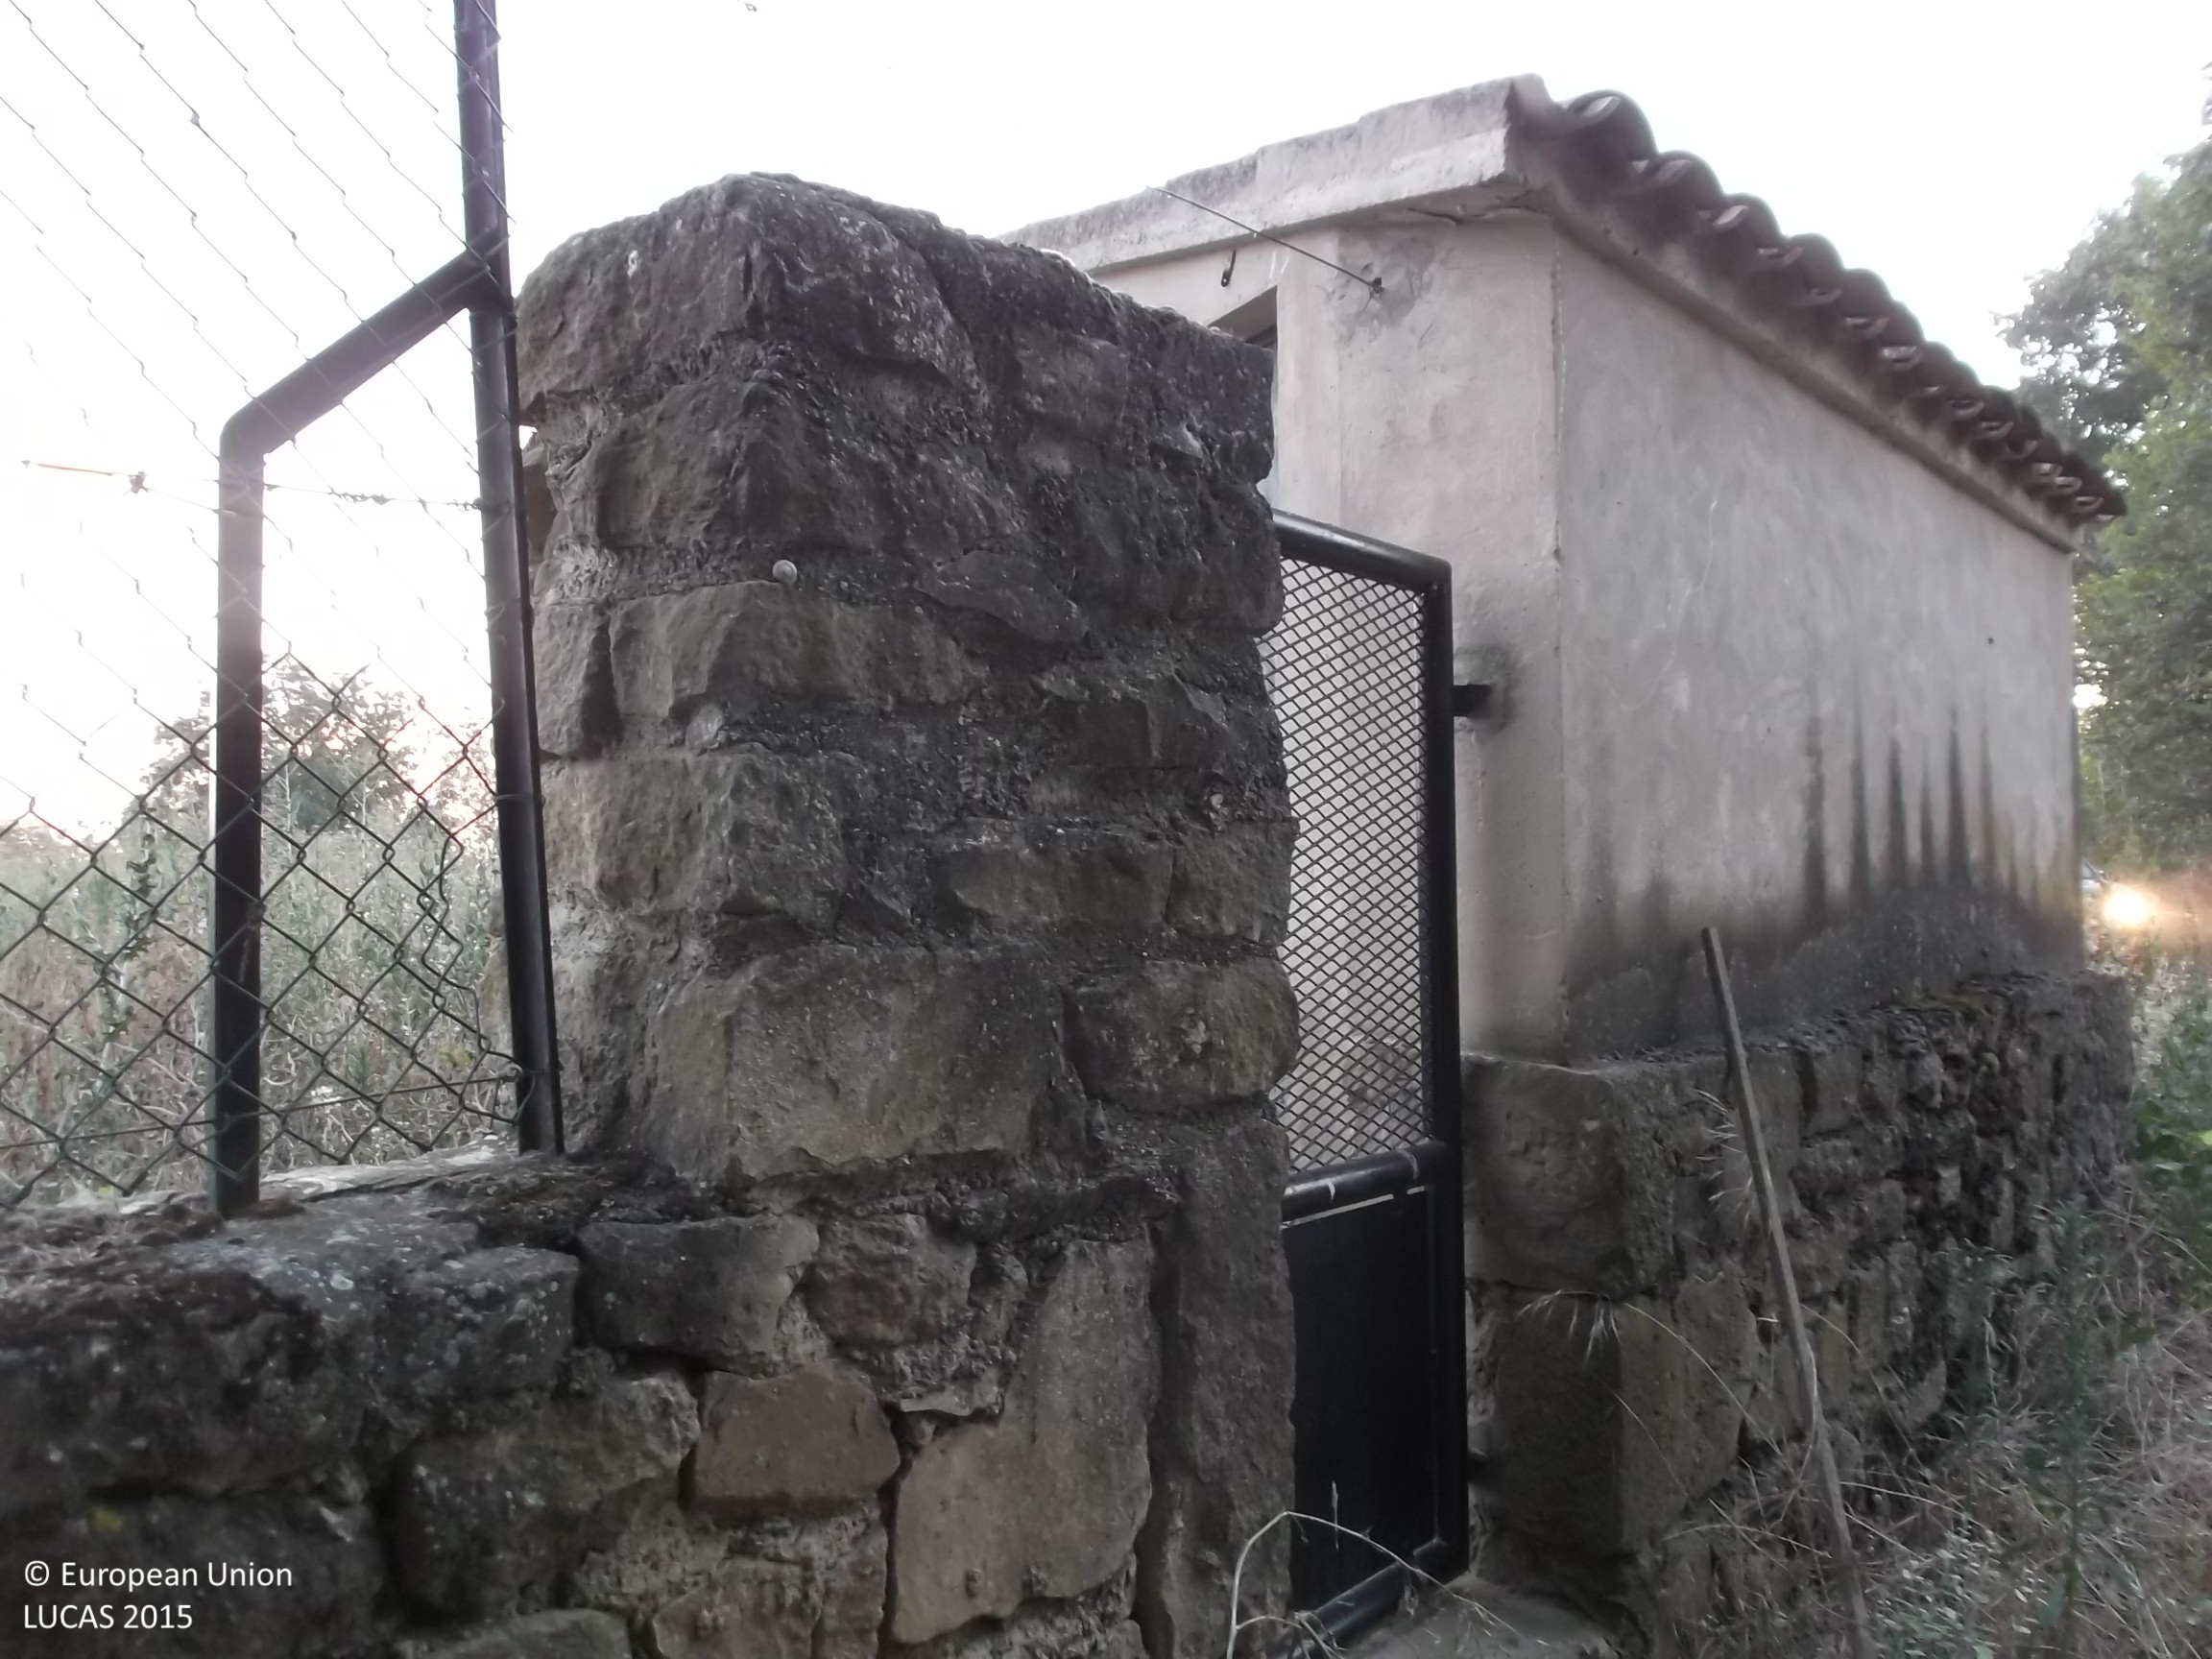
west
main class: Grassland
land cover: Spontaneously vegetated surfaces
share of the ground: > 75 %
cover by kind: herbaceous plants 90 %, unconsolidated bare surface 10 %
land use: Abandoned areas
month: July
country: ES
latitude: 42.4562
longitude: -1.6242
